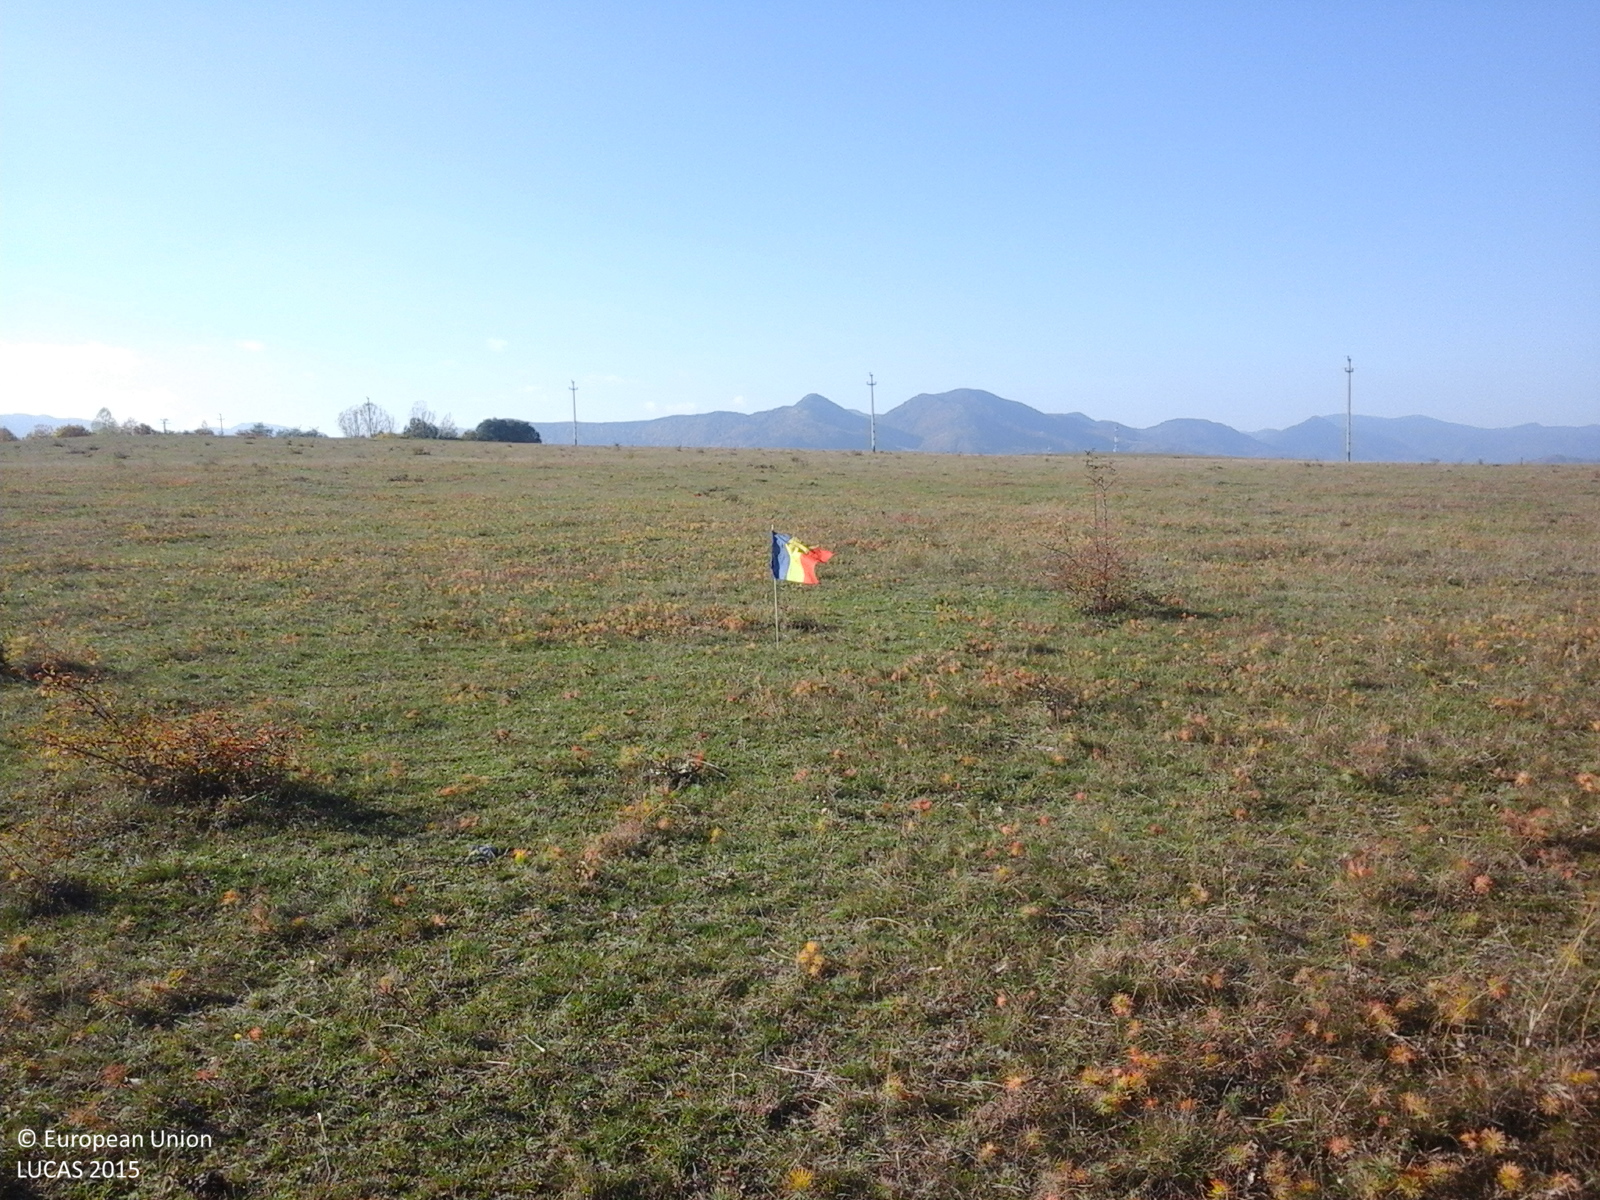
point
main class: Grassland
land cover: Grassland without tree/shrub cover
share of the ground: > 75 %
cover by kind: herbaceous plants 100 %
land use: Agriculture (excluding fallow land and kitchen gardens)
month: October
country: RO
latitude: 45.9046
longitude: 26.7250
